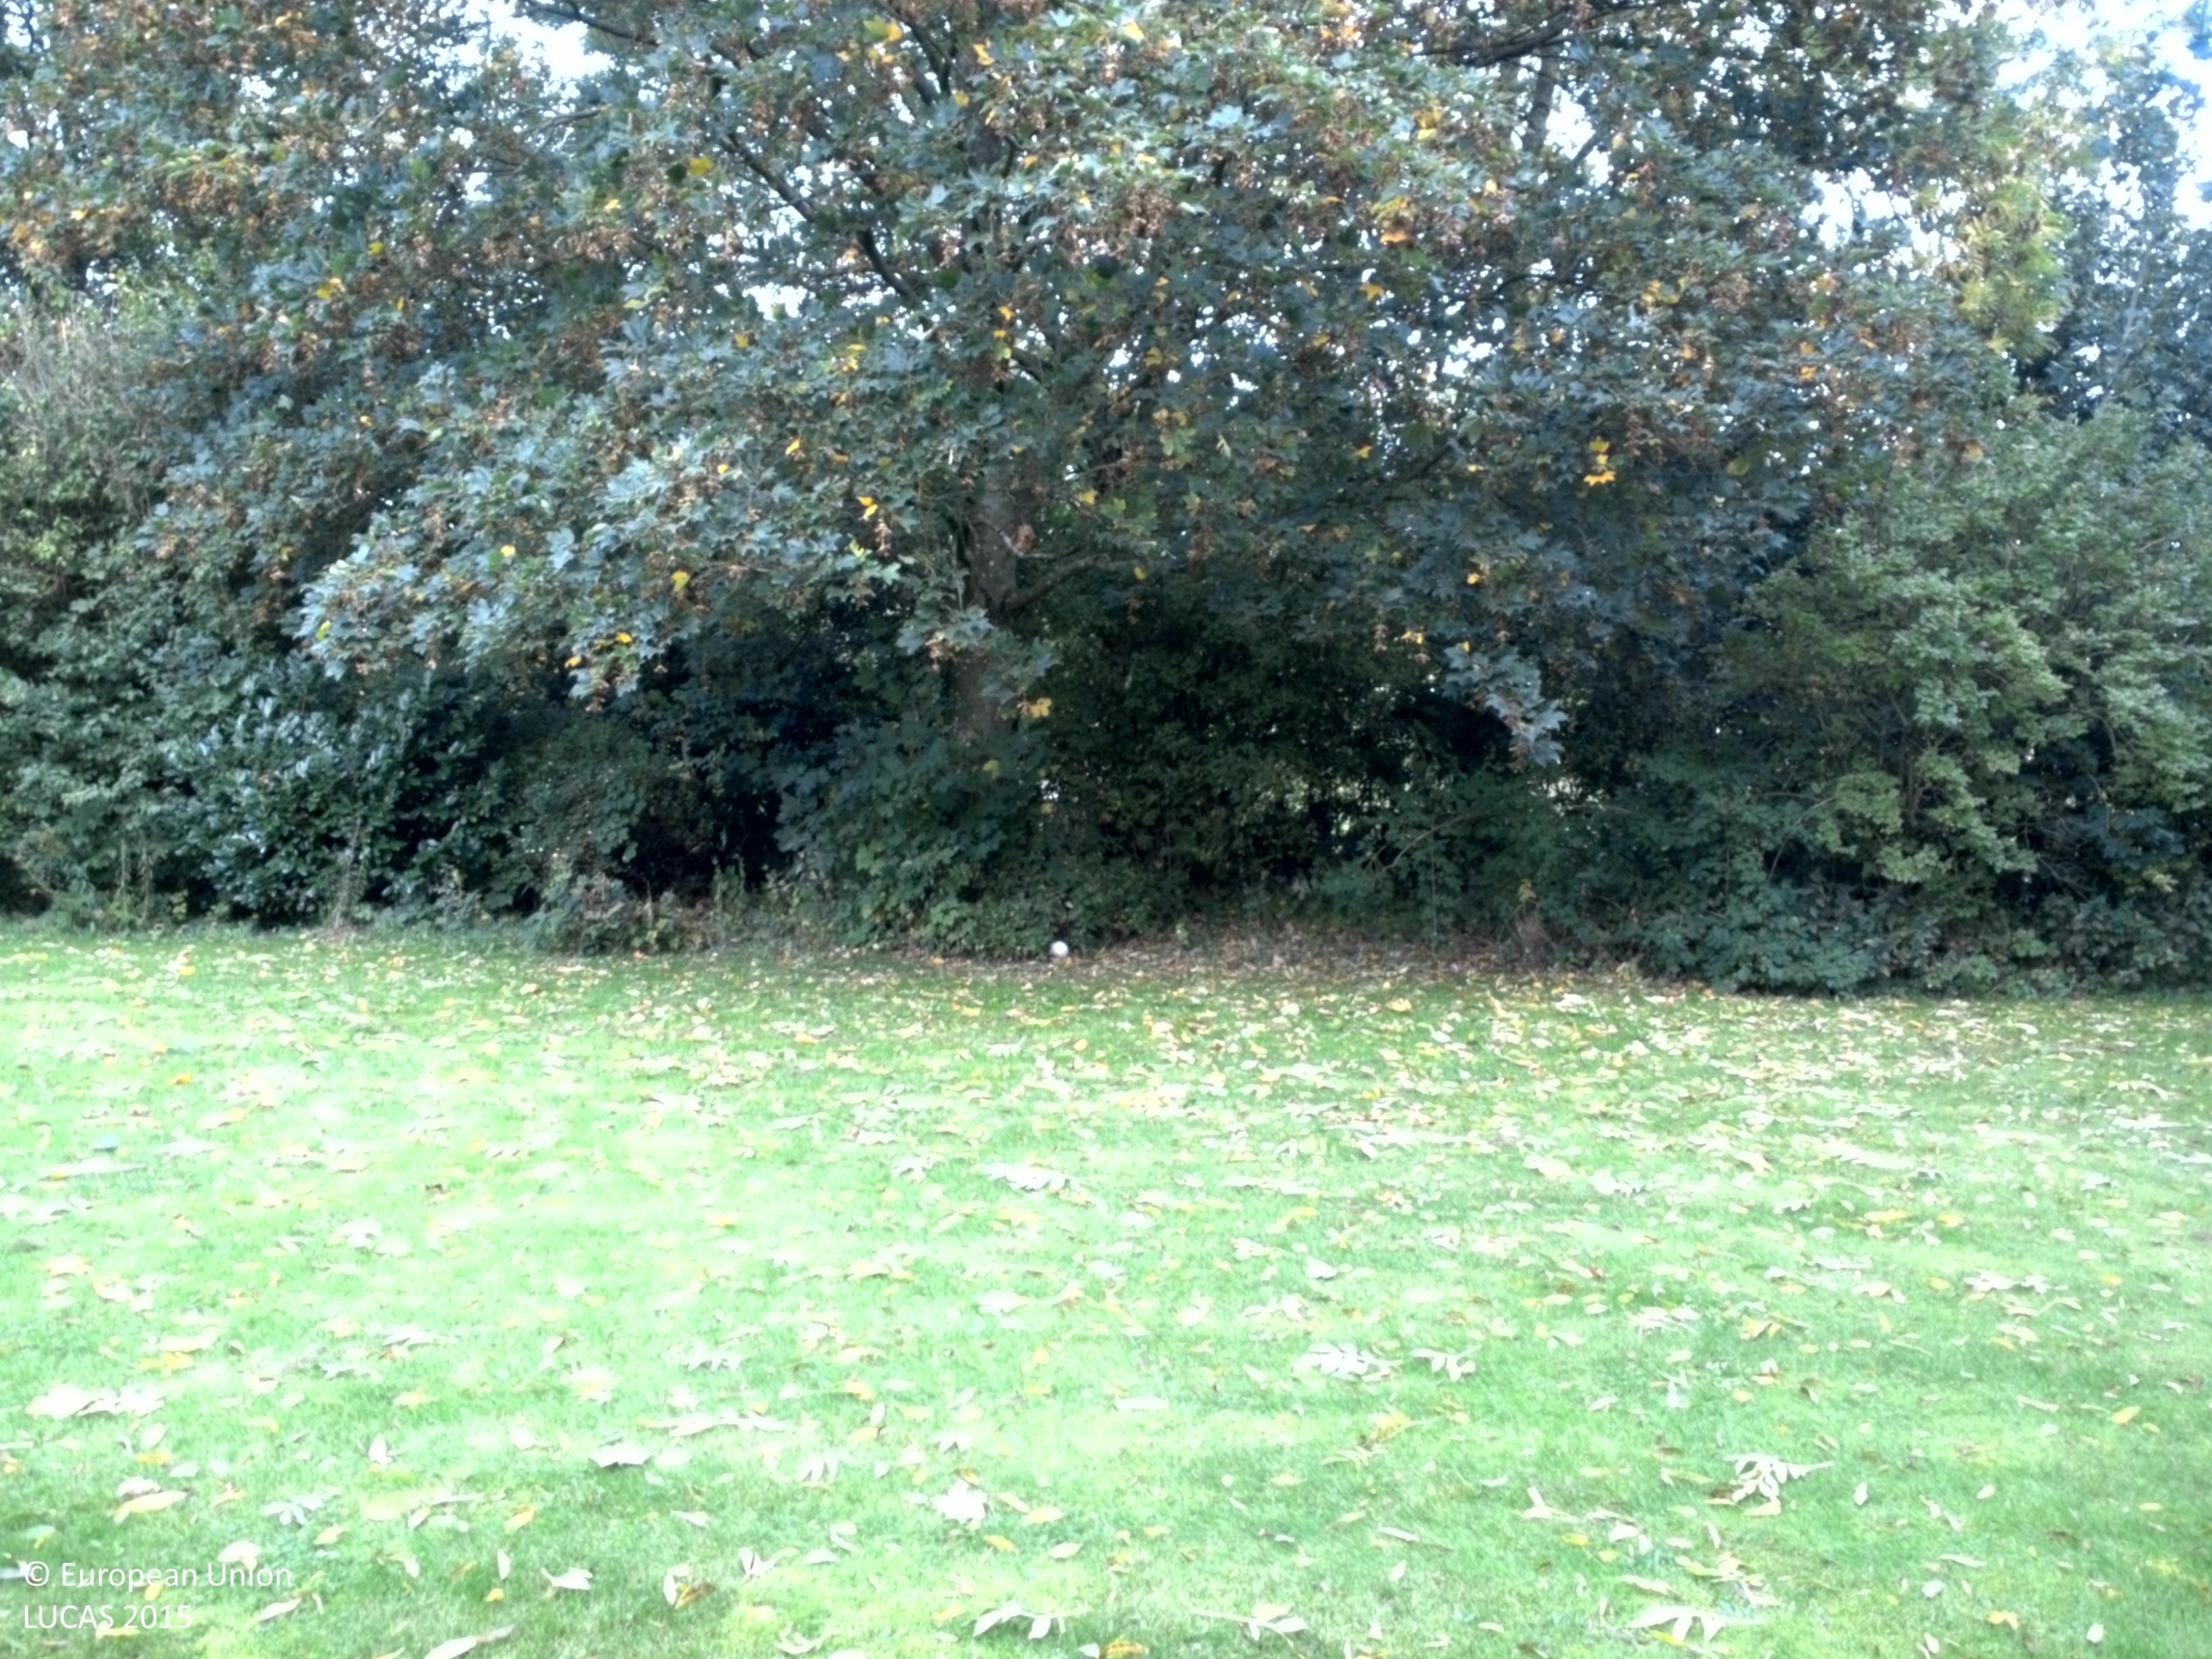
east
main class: Grassland
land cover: Grassland without tree/shrub cover
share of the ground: > 75 %
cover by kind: herbaceous plants 100 %
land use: Residential
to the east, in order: Grassland without tree/shrub cover; Fences; Managed hedges; Electric lines; Grassland without tree/shrub cover; Fences; Groves; Artificial constructions in urban areas; Grassland without tree/shrub cover; Dry stone walls
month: October
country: SE
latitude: 55.5790
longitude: 14.2022
